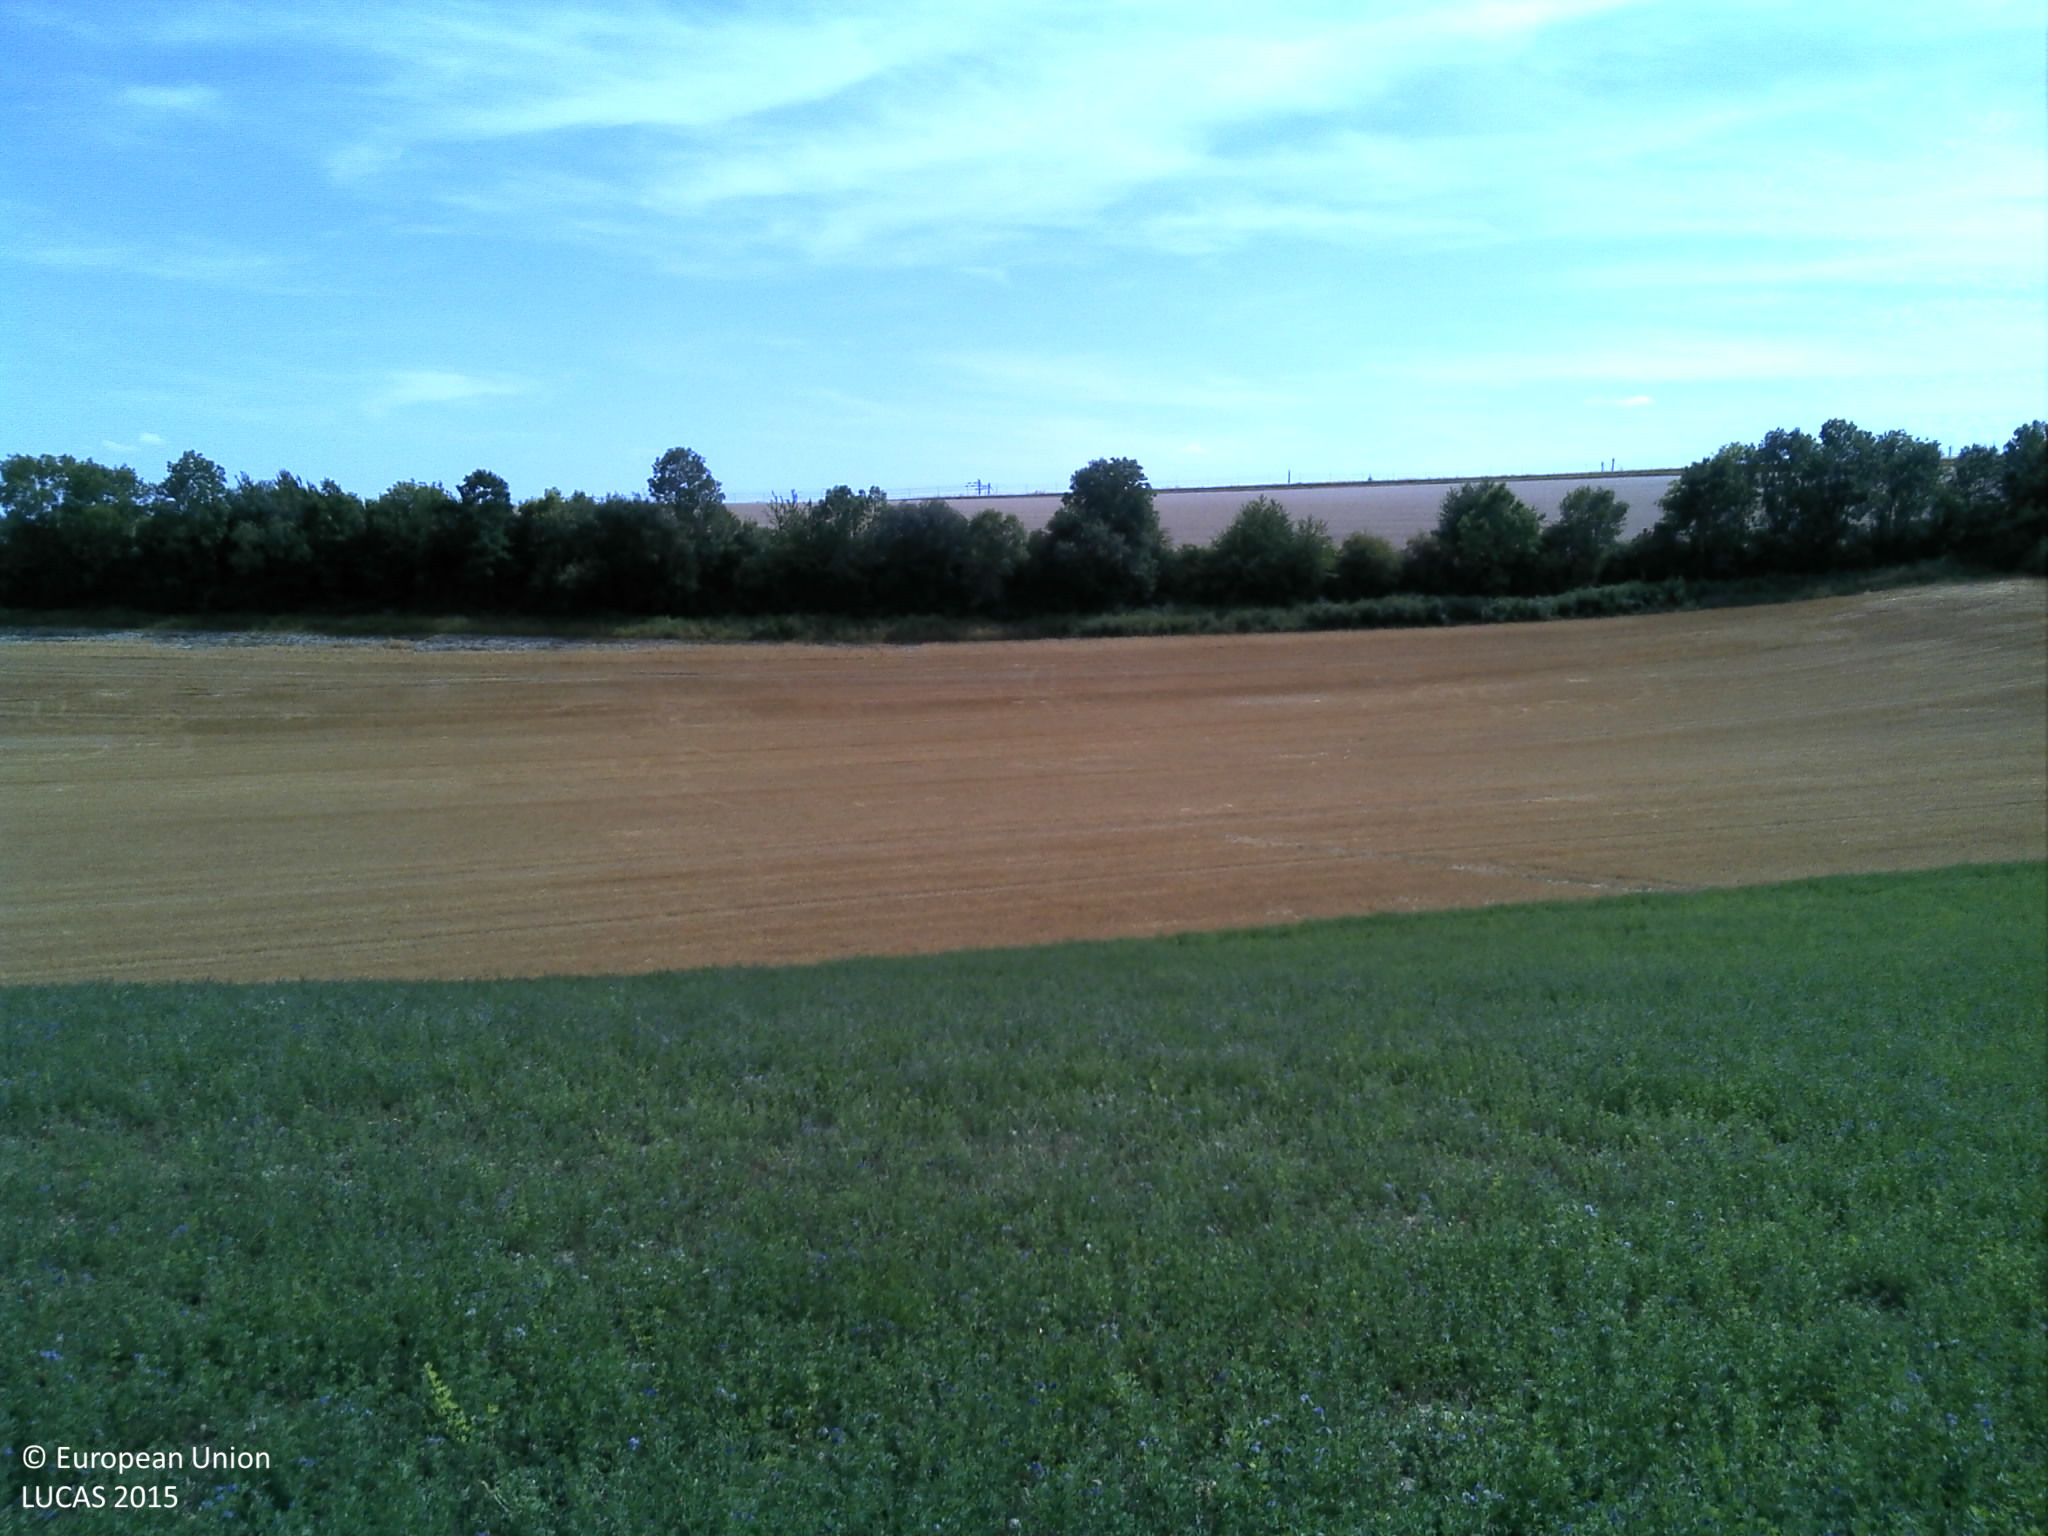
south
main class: Cropland
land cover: Lucerne
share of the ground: > 75 %
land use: Agriculture (excluding fallow land and kitchen gardens)
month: August
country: FR
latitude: 49.0197
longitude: 4.7875
